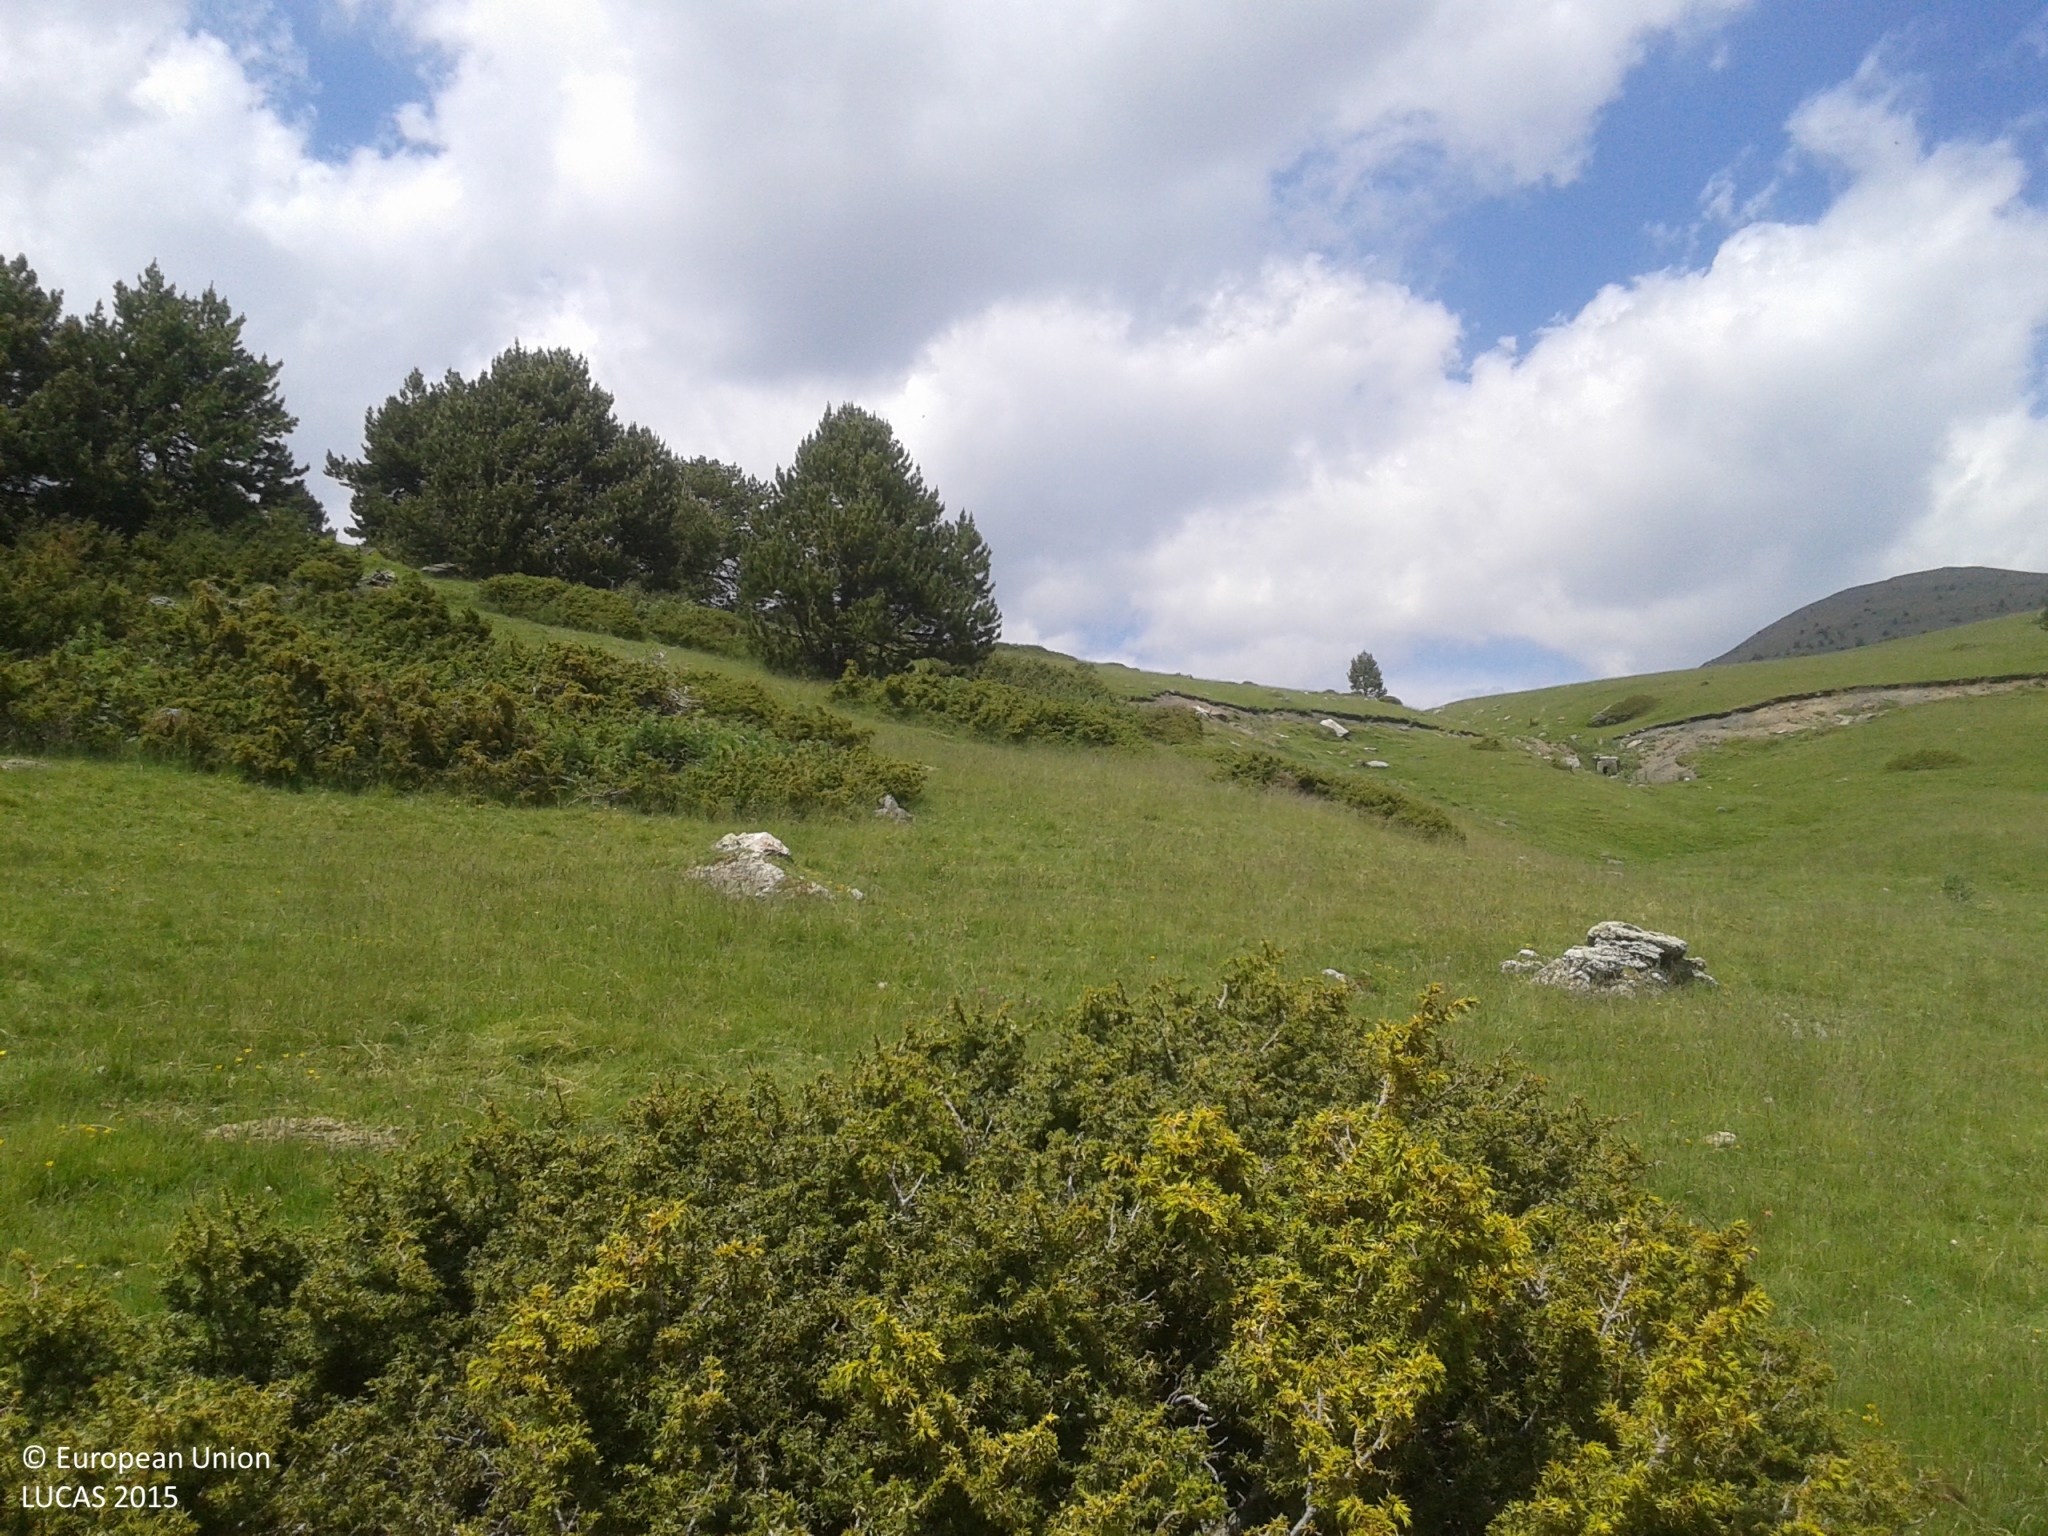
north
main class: Shrubland
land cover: Shrubland with sparse tree cover
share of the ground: > 75 %
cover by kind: herbaceous plants 85 %, shrubs 10 %, coniferous forest trees 5 %
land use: Agriculture (excluding fallow land and kitchen gardens)
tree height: > 5 m
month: June
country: ES
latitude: 42.4126
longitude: 1.5891
